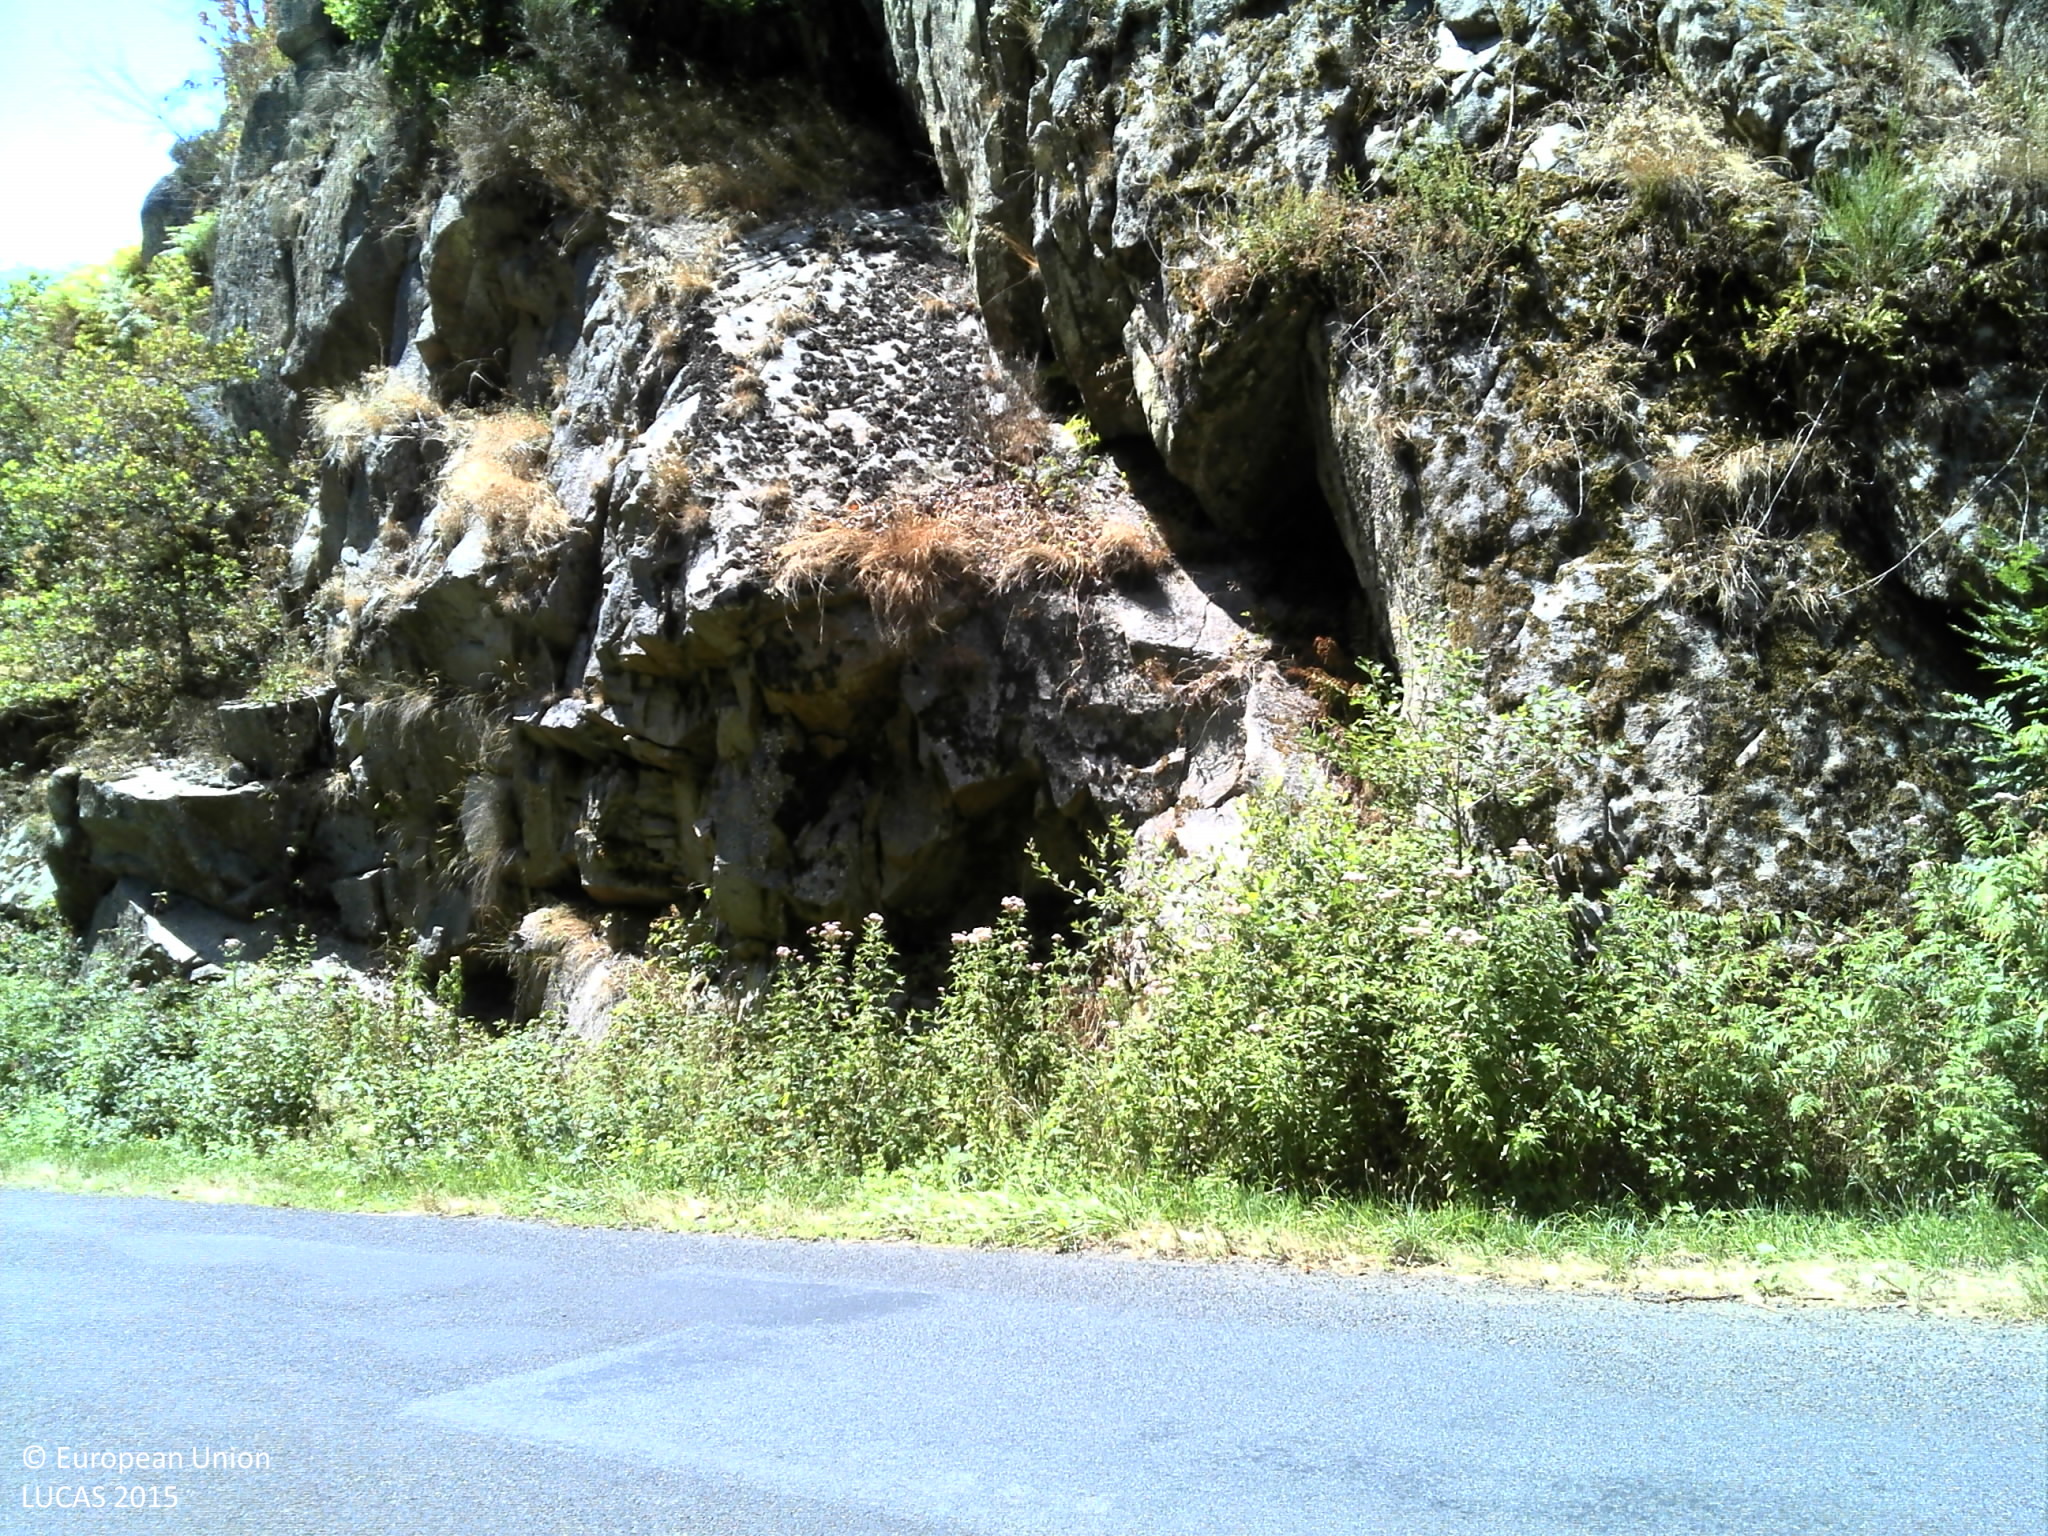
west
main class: Woodland
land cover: Spruce dominated mixed woodland
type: broadleaved evergreen forest
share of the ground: > 75 %
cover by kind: coniferous forest trees 40 %, broadleaved forest trees 20 %, herbaceous plants 20 %, shrubs 10 %, lichens and mosses 10 %
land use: Forestry
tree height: > 5 m
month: July
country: FR
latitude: 45.5528
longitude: 3.4301
